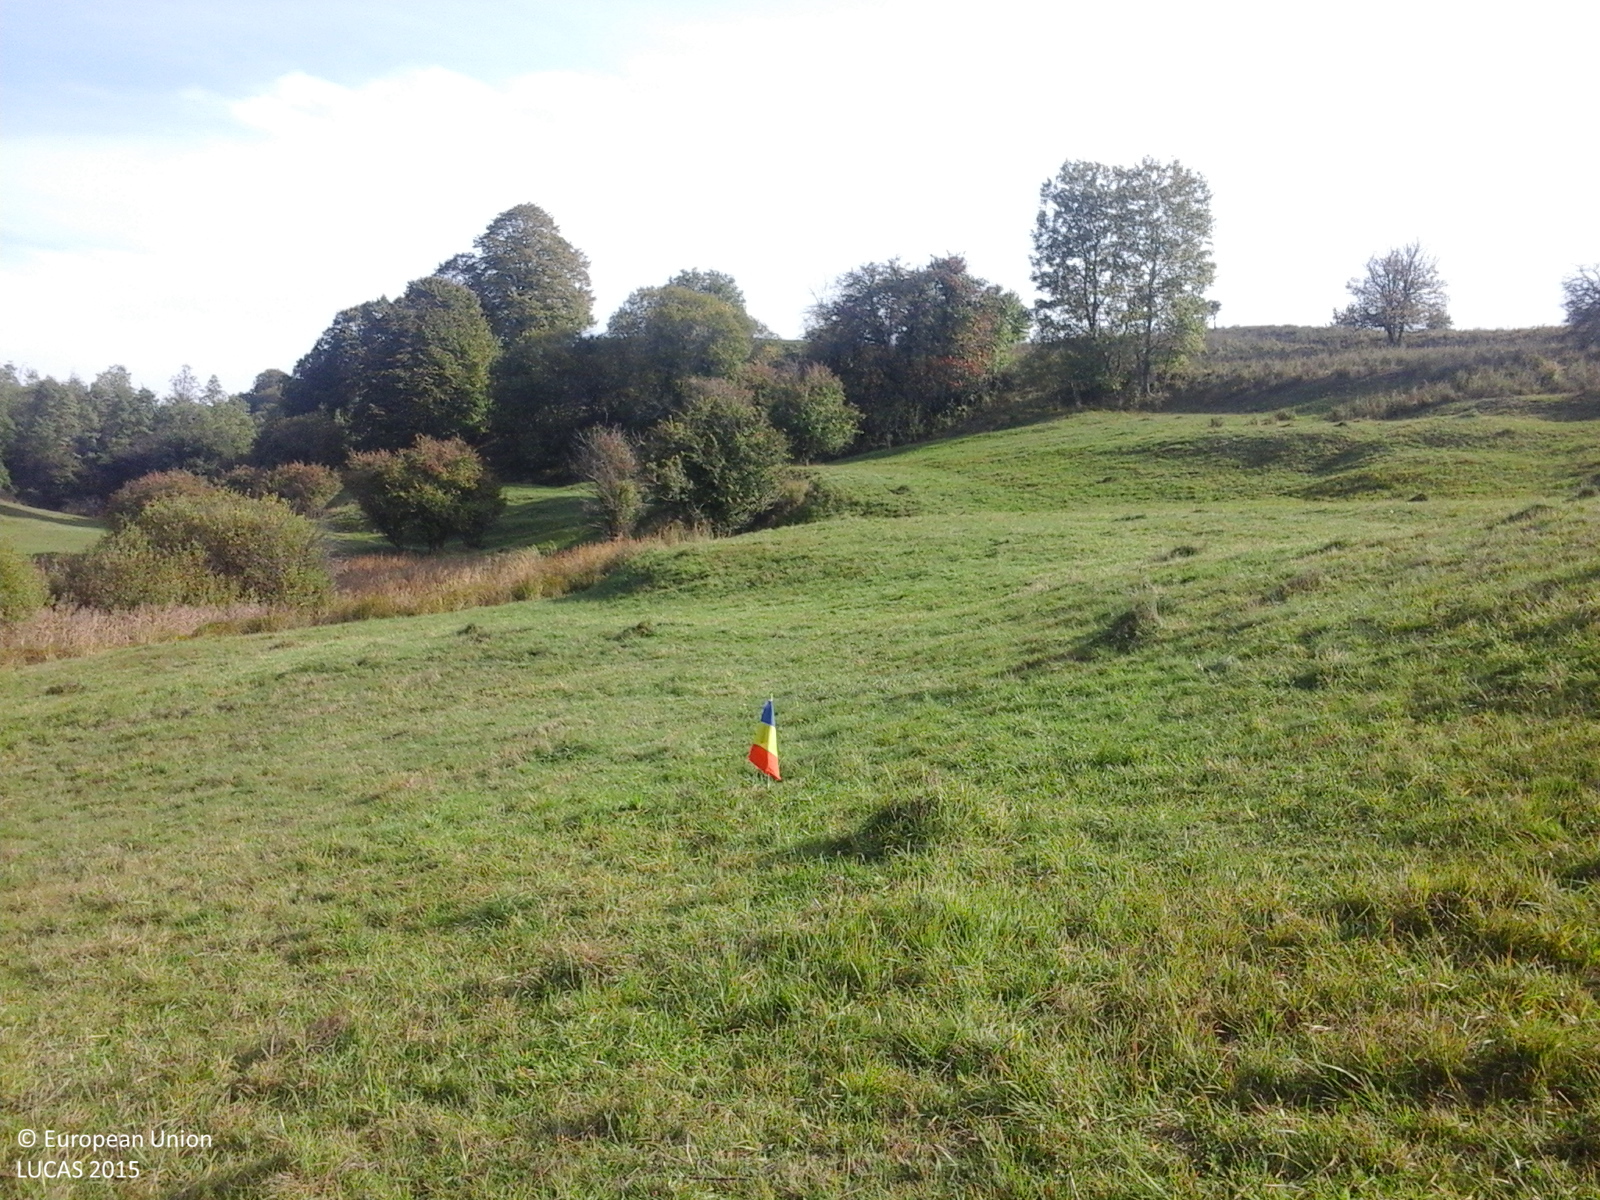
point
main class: Grassland
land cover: Grassland without tree/shrub cover
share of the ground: > 75 %
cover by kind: herbaceous plants 100 %
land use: Agriculture (excluding fallow land and kitchen gardens)
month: October
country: RO
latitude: 45.9497
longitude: 24.9672
